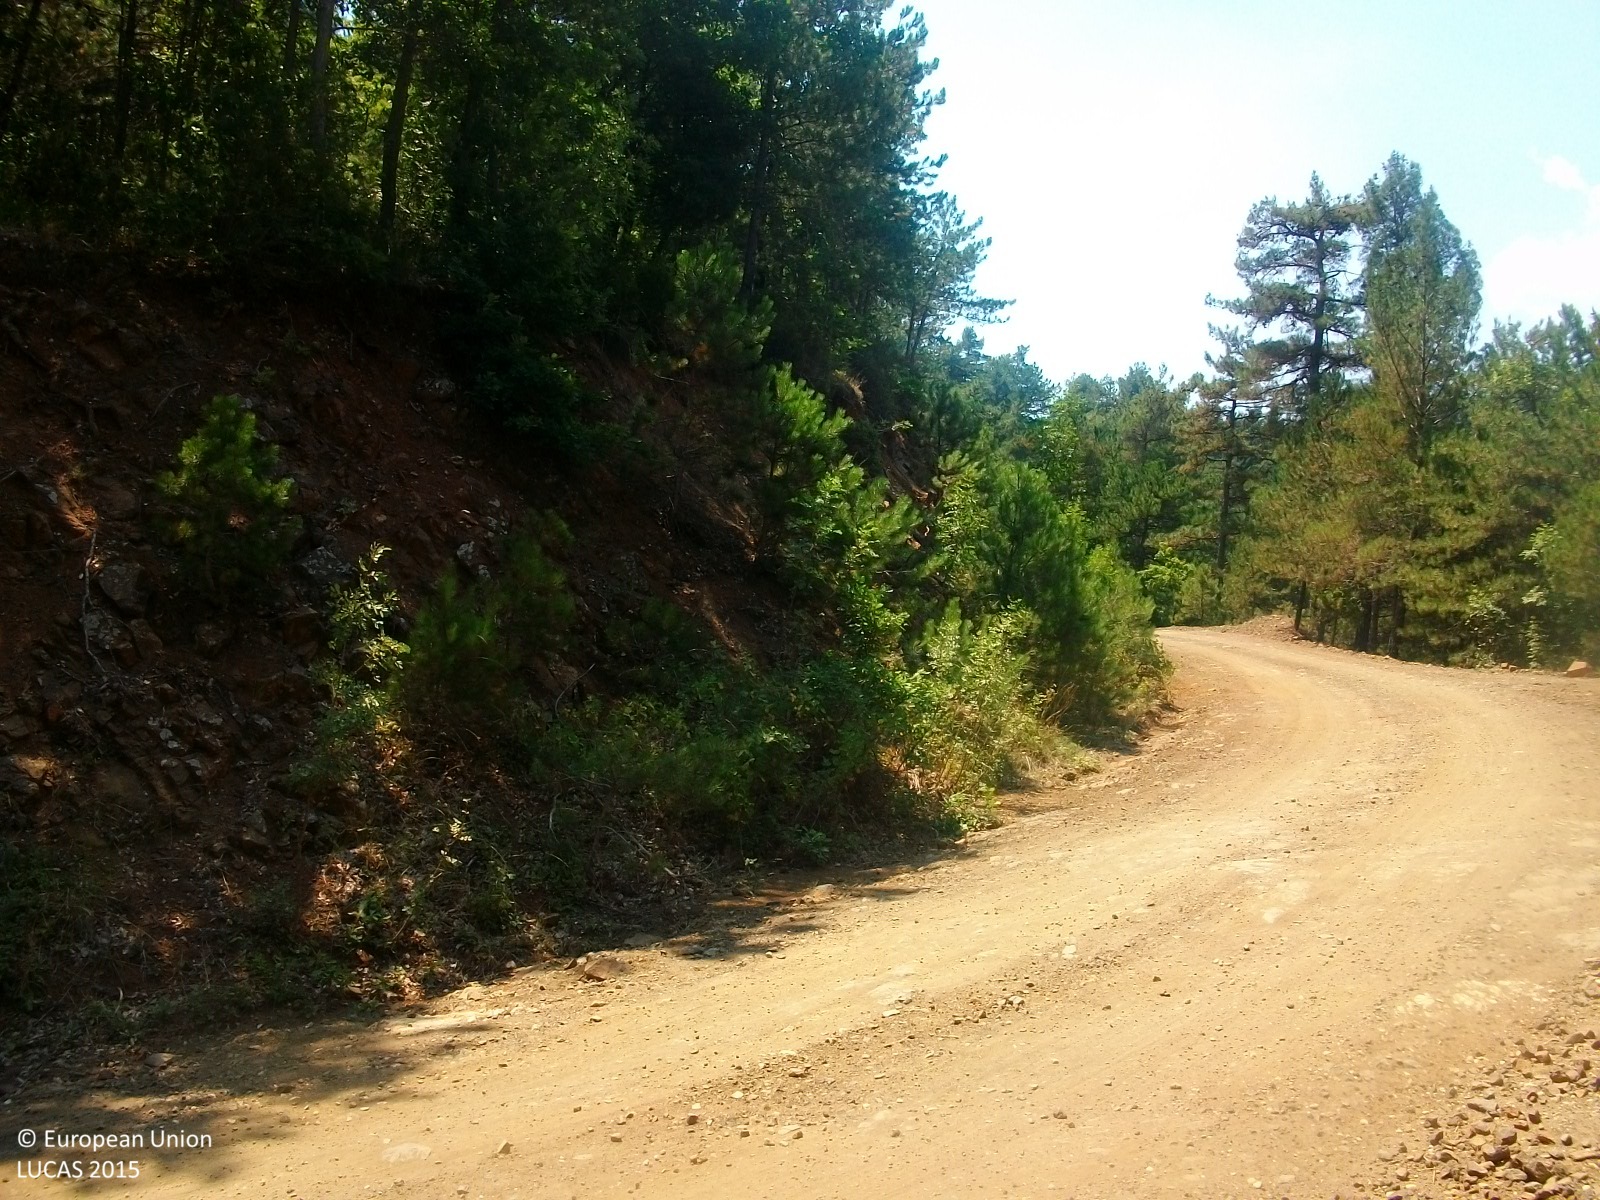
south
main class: Woodland
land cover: Pine dominated mixed woodland
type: coniferous forest of the mediterranean region
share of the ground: > 75 %
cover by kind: coniferous forest trees 50 %, broadleaved forest trees 40 %, shrubs 10 %
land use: Forestry
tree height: > 5 m
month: July
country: GR
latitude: 41.1436
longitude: 26.1626
